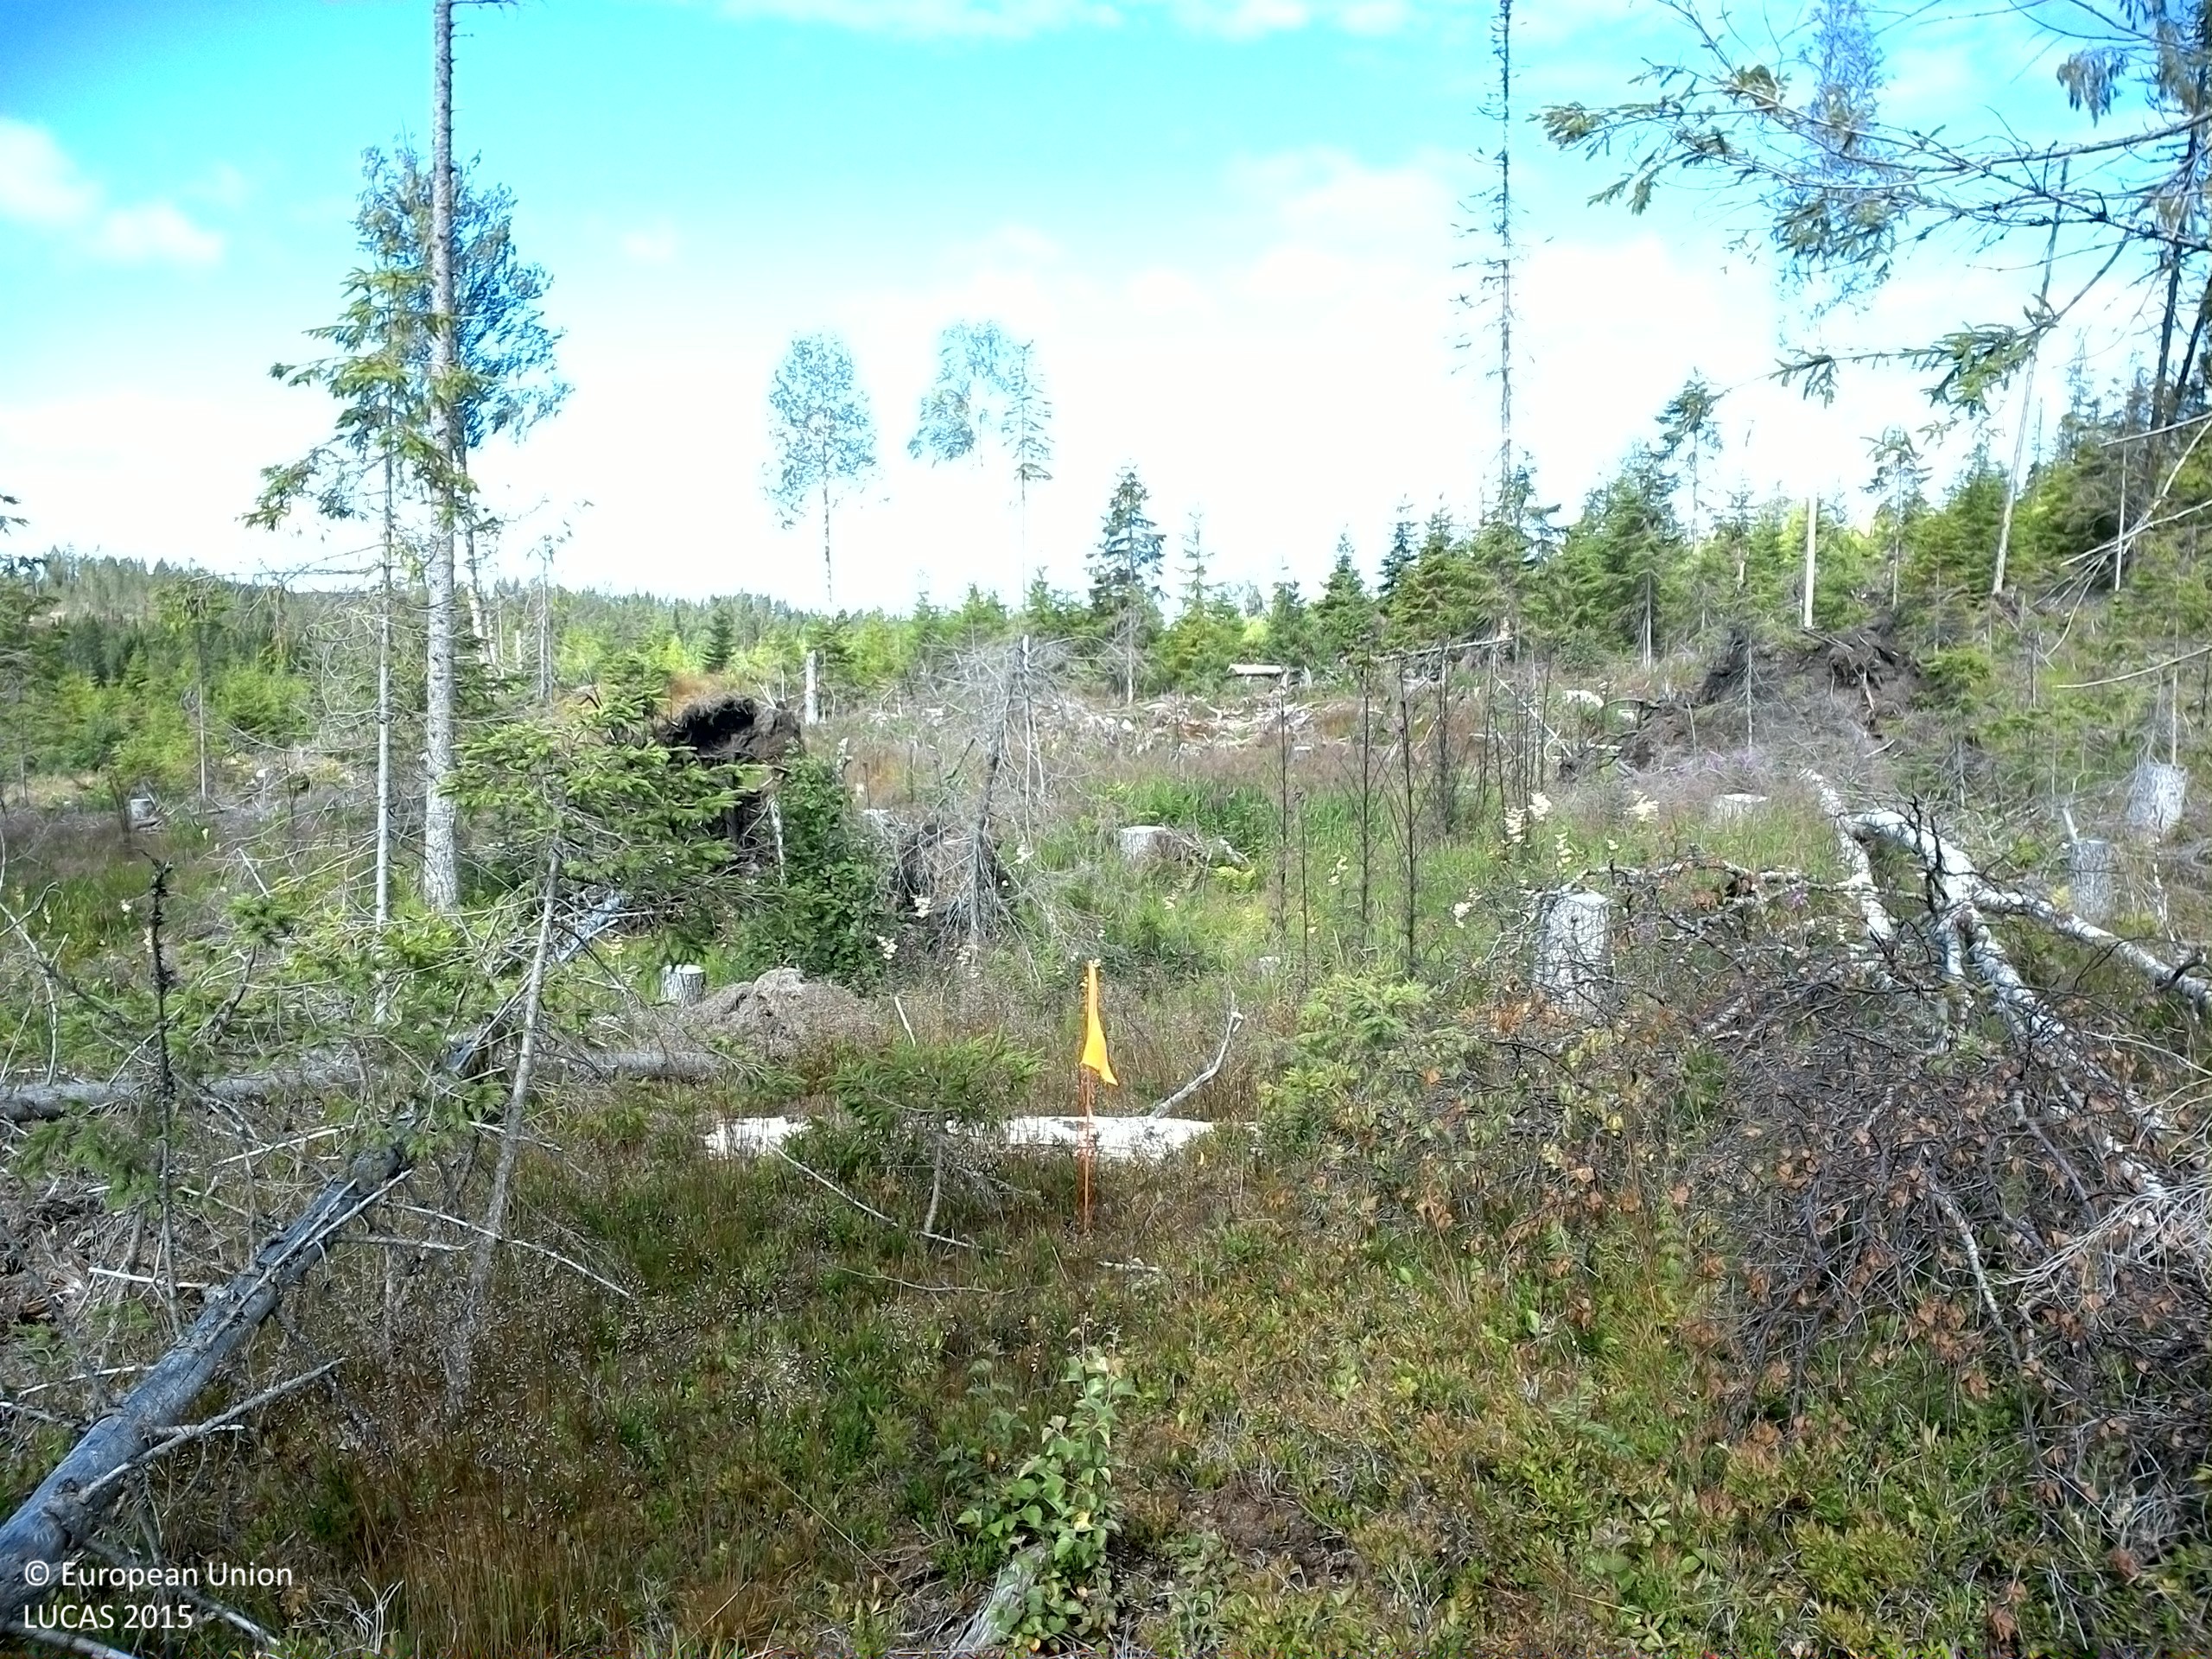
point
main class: Woodland
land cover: Spruce dominated mixed woodland
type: boreal forest
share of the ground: 10 - 25 %
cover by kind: shrubs 45 %, herbaceous plants 25 %, coniferous forest trees 10 %, lichens and mosses 10 %, broadleaved forest trees 5 %, consolidated bare surface 5 %
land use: Forestry
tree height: < 5 m
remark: Clear cut
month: August
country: SE
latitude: 62.8496
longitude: 16.5577
